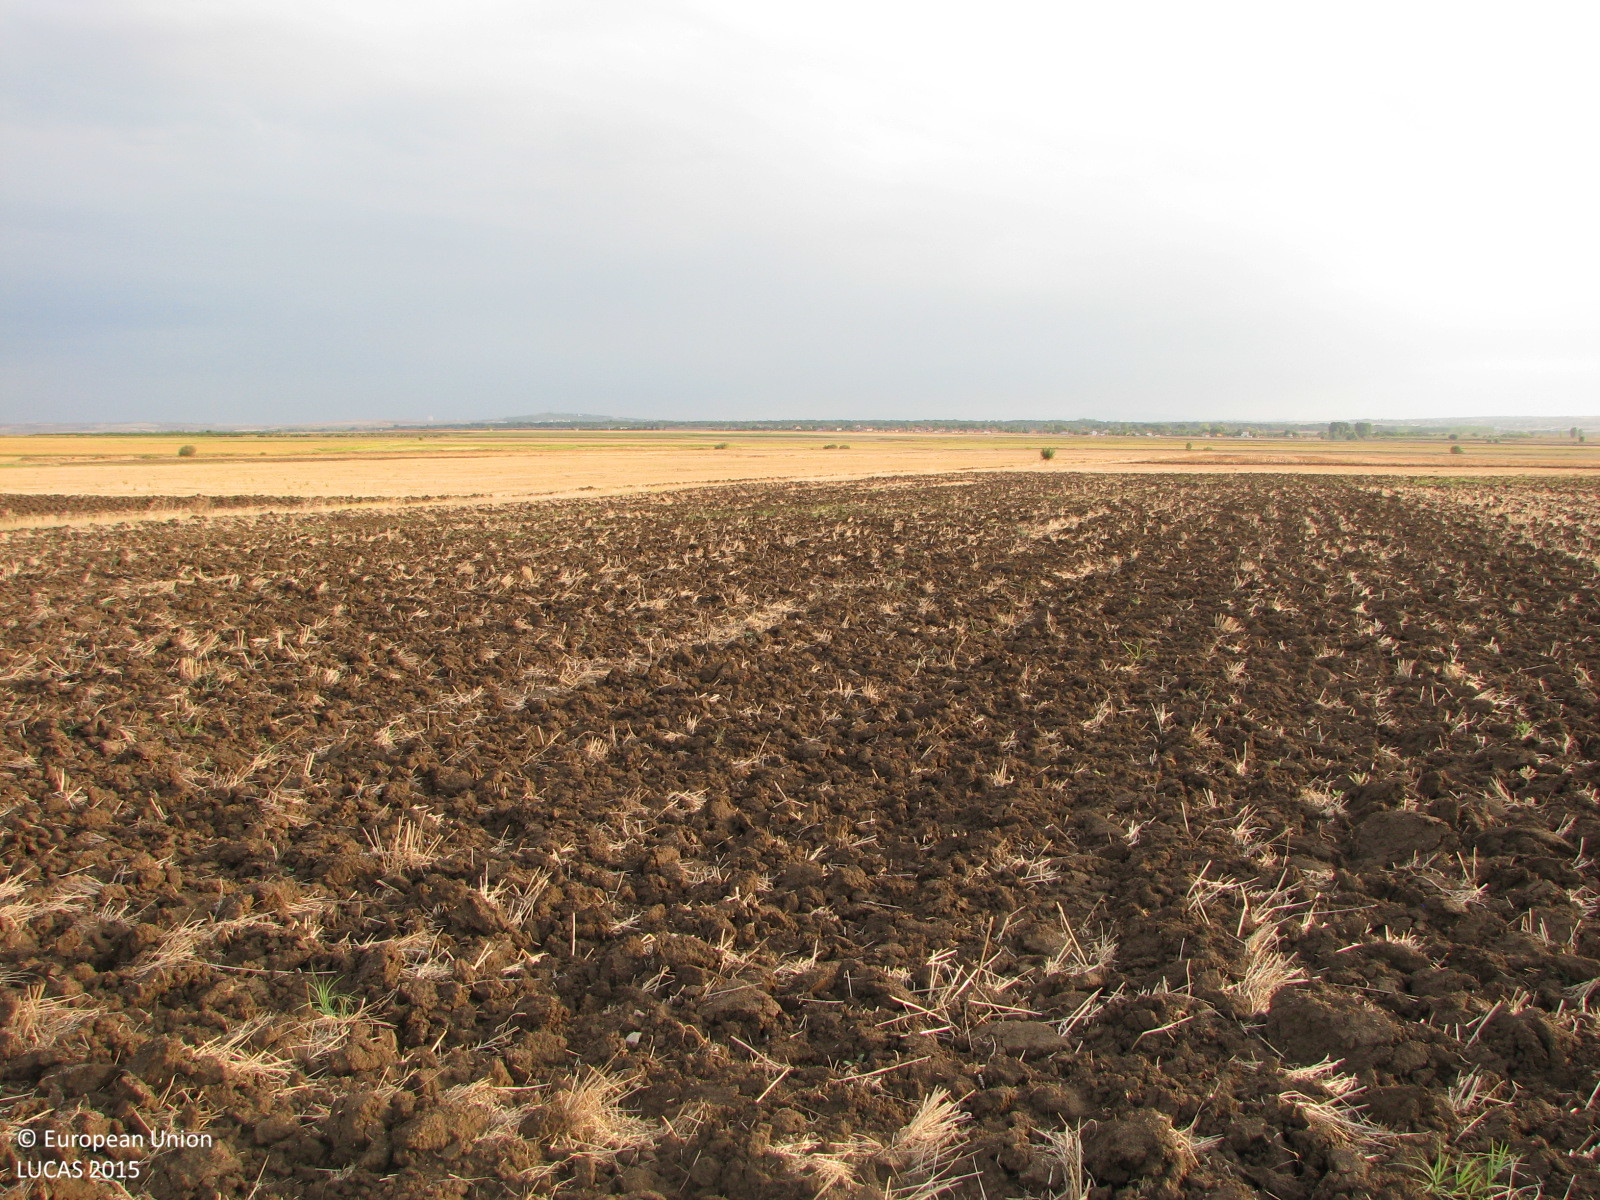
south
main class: Cropland
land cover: Common wheat
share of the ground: < 10 %
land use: Agriculture (excluding fallow land and kitchen gardens)
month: September
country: BG
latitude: 42.5902
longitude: 26.5333
